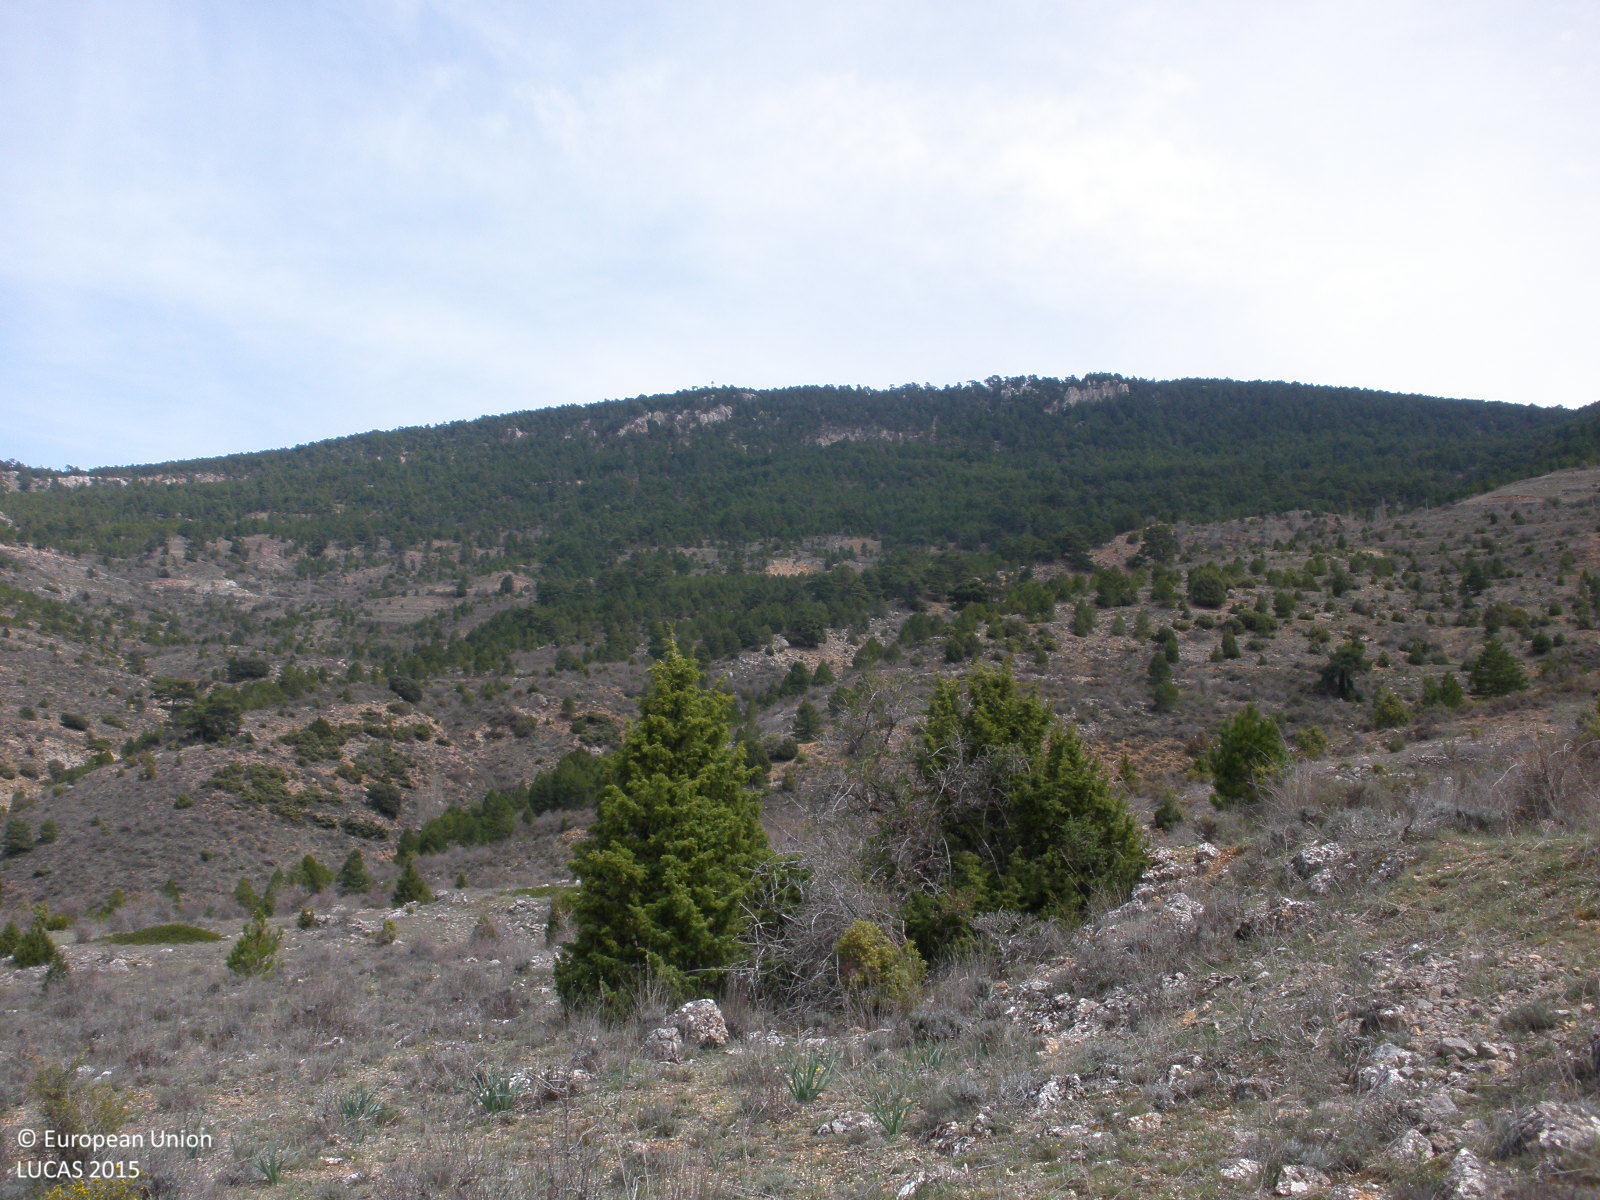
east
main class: Shrubland
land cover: Shrubland with sparse tree cover
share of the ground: > 75 %
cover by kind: shrubs 60 %, herbaceous plants 20 %, consolidated bare surface 15 %, coniferous forest trees 5 %
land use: Agriculture (excluding fallow land and kitchen gardens)
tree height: < 5 m
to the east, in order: Shrubland with sparse tree cover; Other coniferous woodland; Rivers and streams; Shrubland with sparse tree cover; Other coniferous woodland
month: April
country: ES
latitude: 40.1541
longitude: -1.0317
